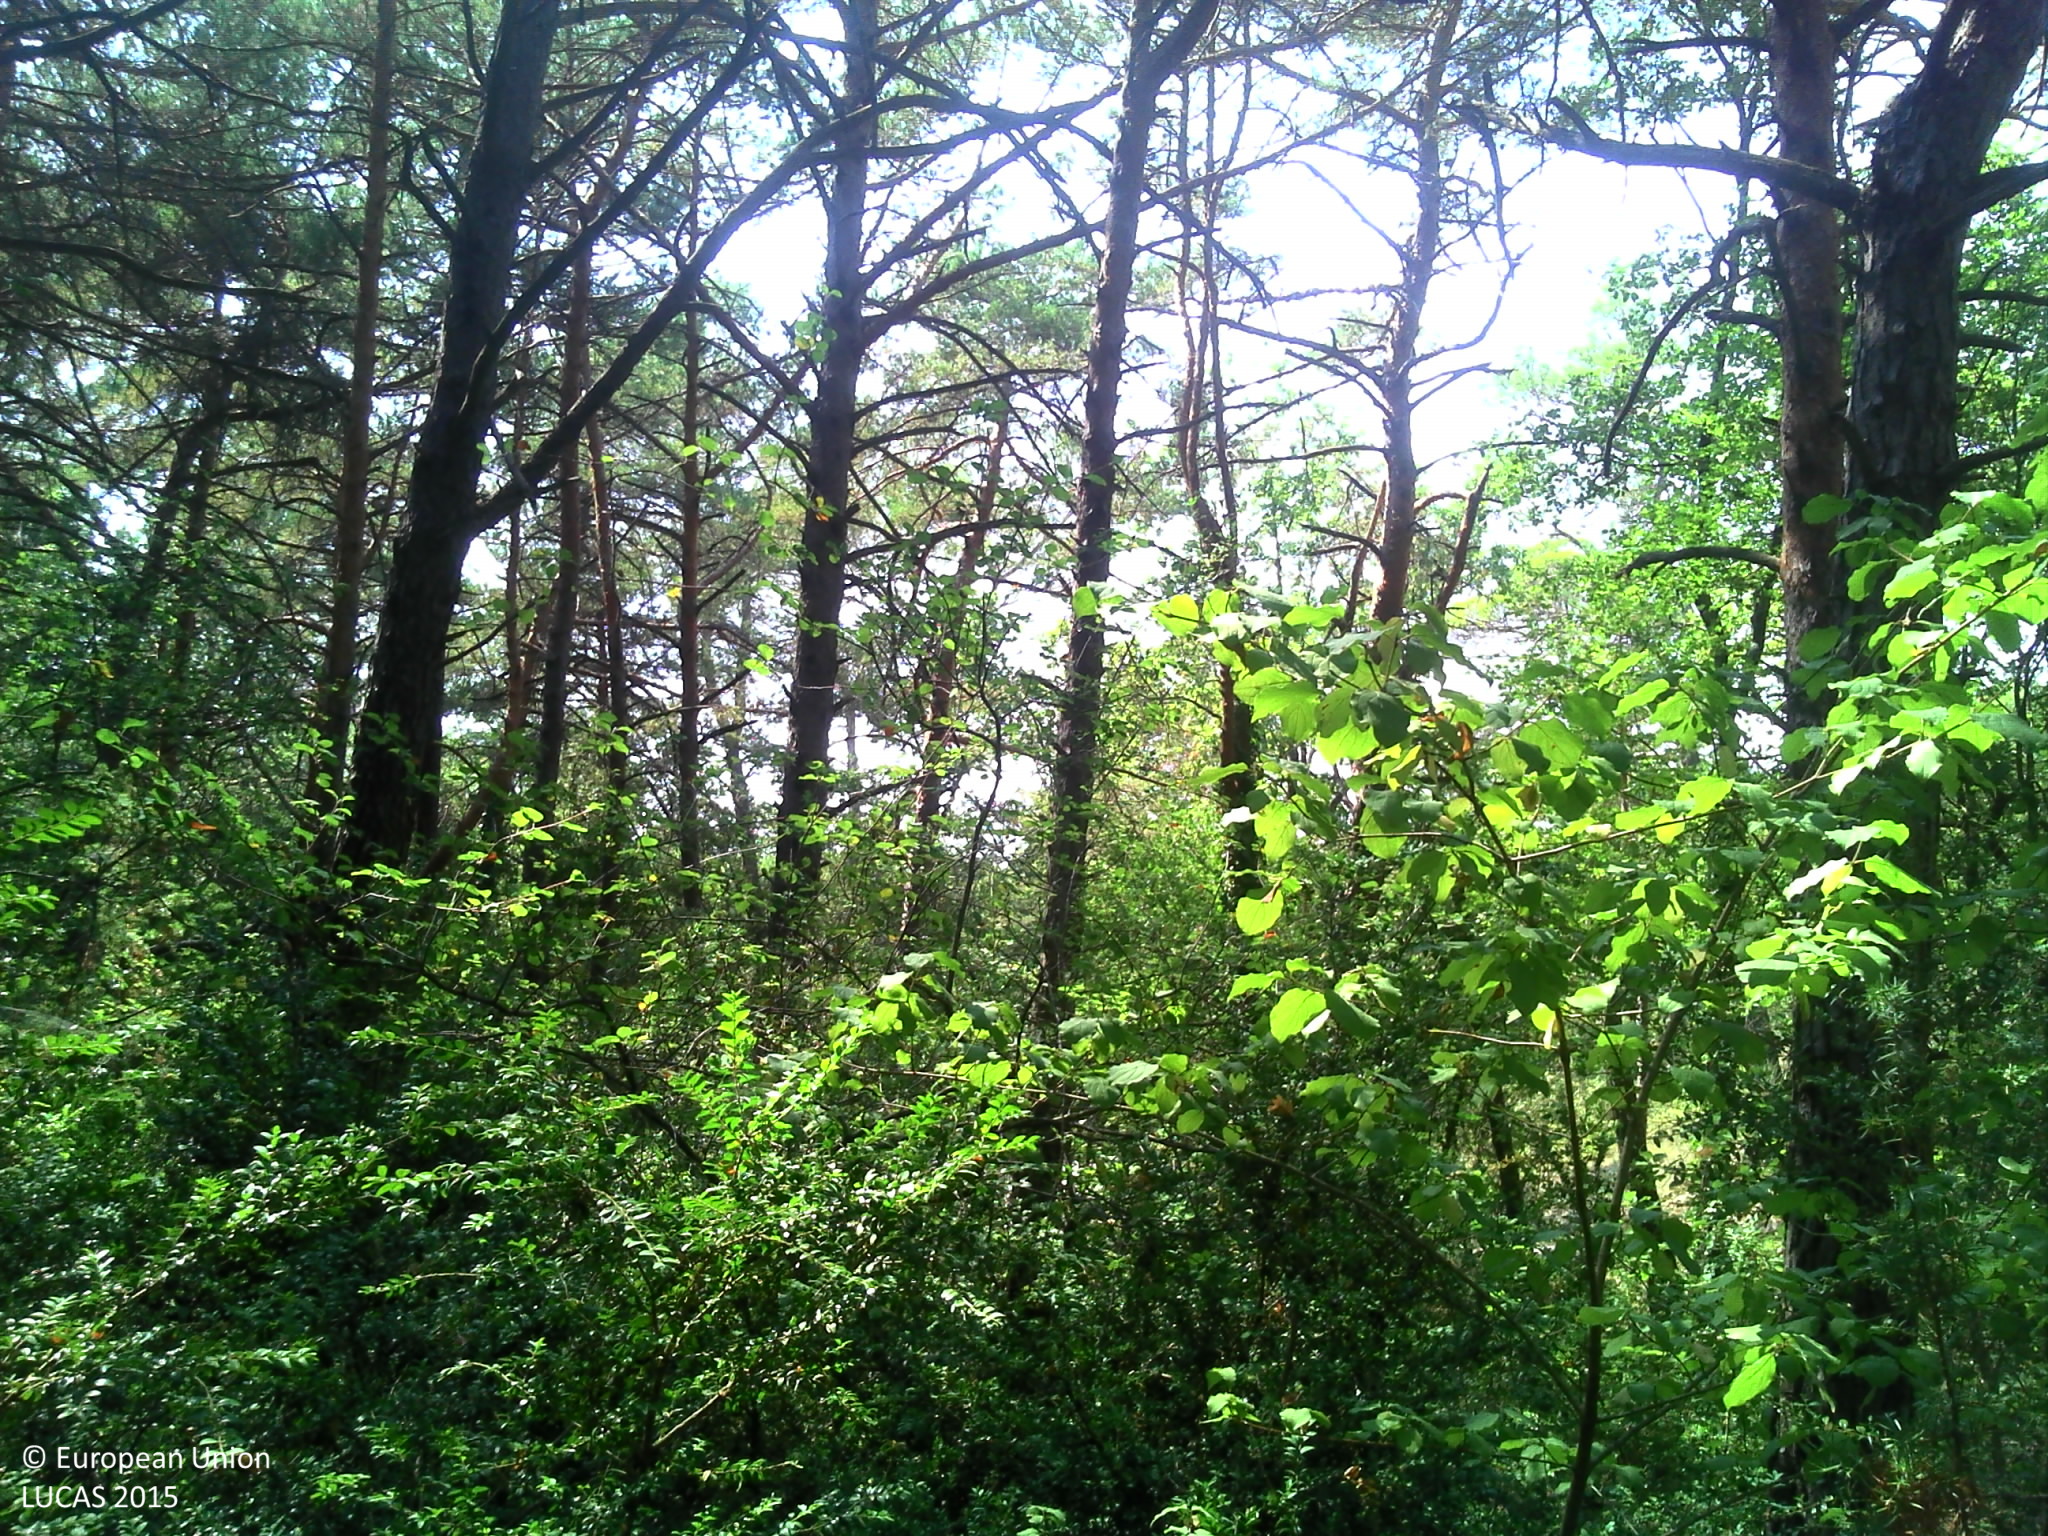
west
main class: Woodland
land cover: Pine dominated mixed woodland
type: thermophilous deciduous forest
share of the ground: > 75 %
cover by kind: coniferous forest trees 50 %, broadleaved forest trees 25 %, shrubs 25 %
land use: Semi-natural and natural areas not in use
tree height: > 5 m
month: August
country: FR
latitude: 43.5866
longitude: 6.4785
